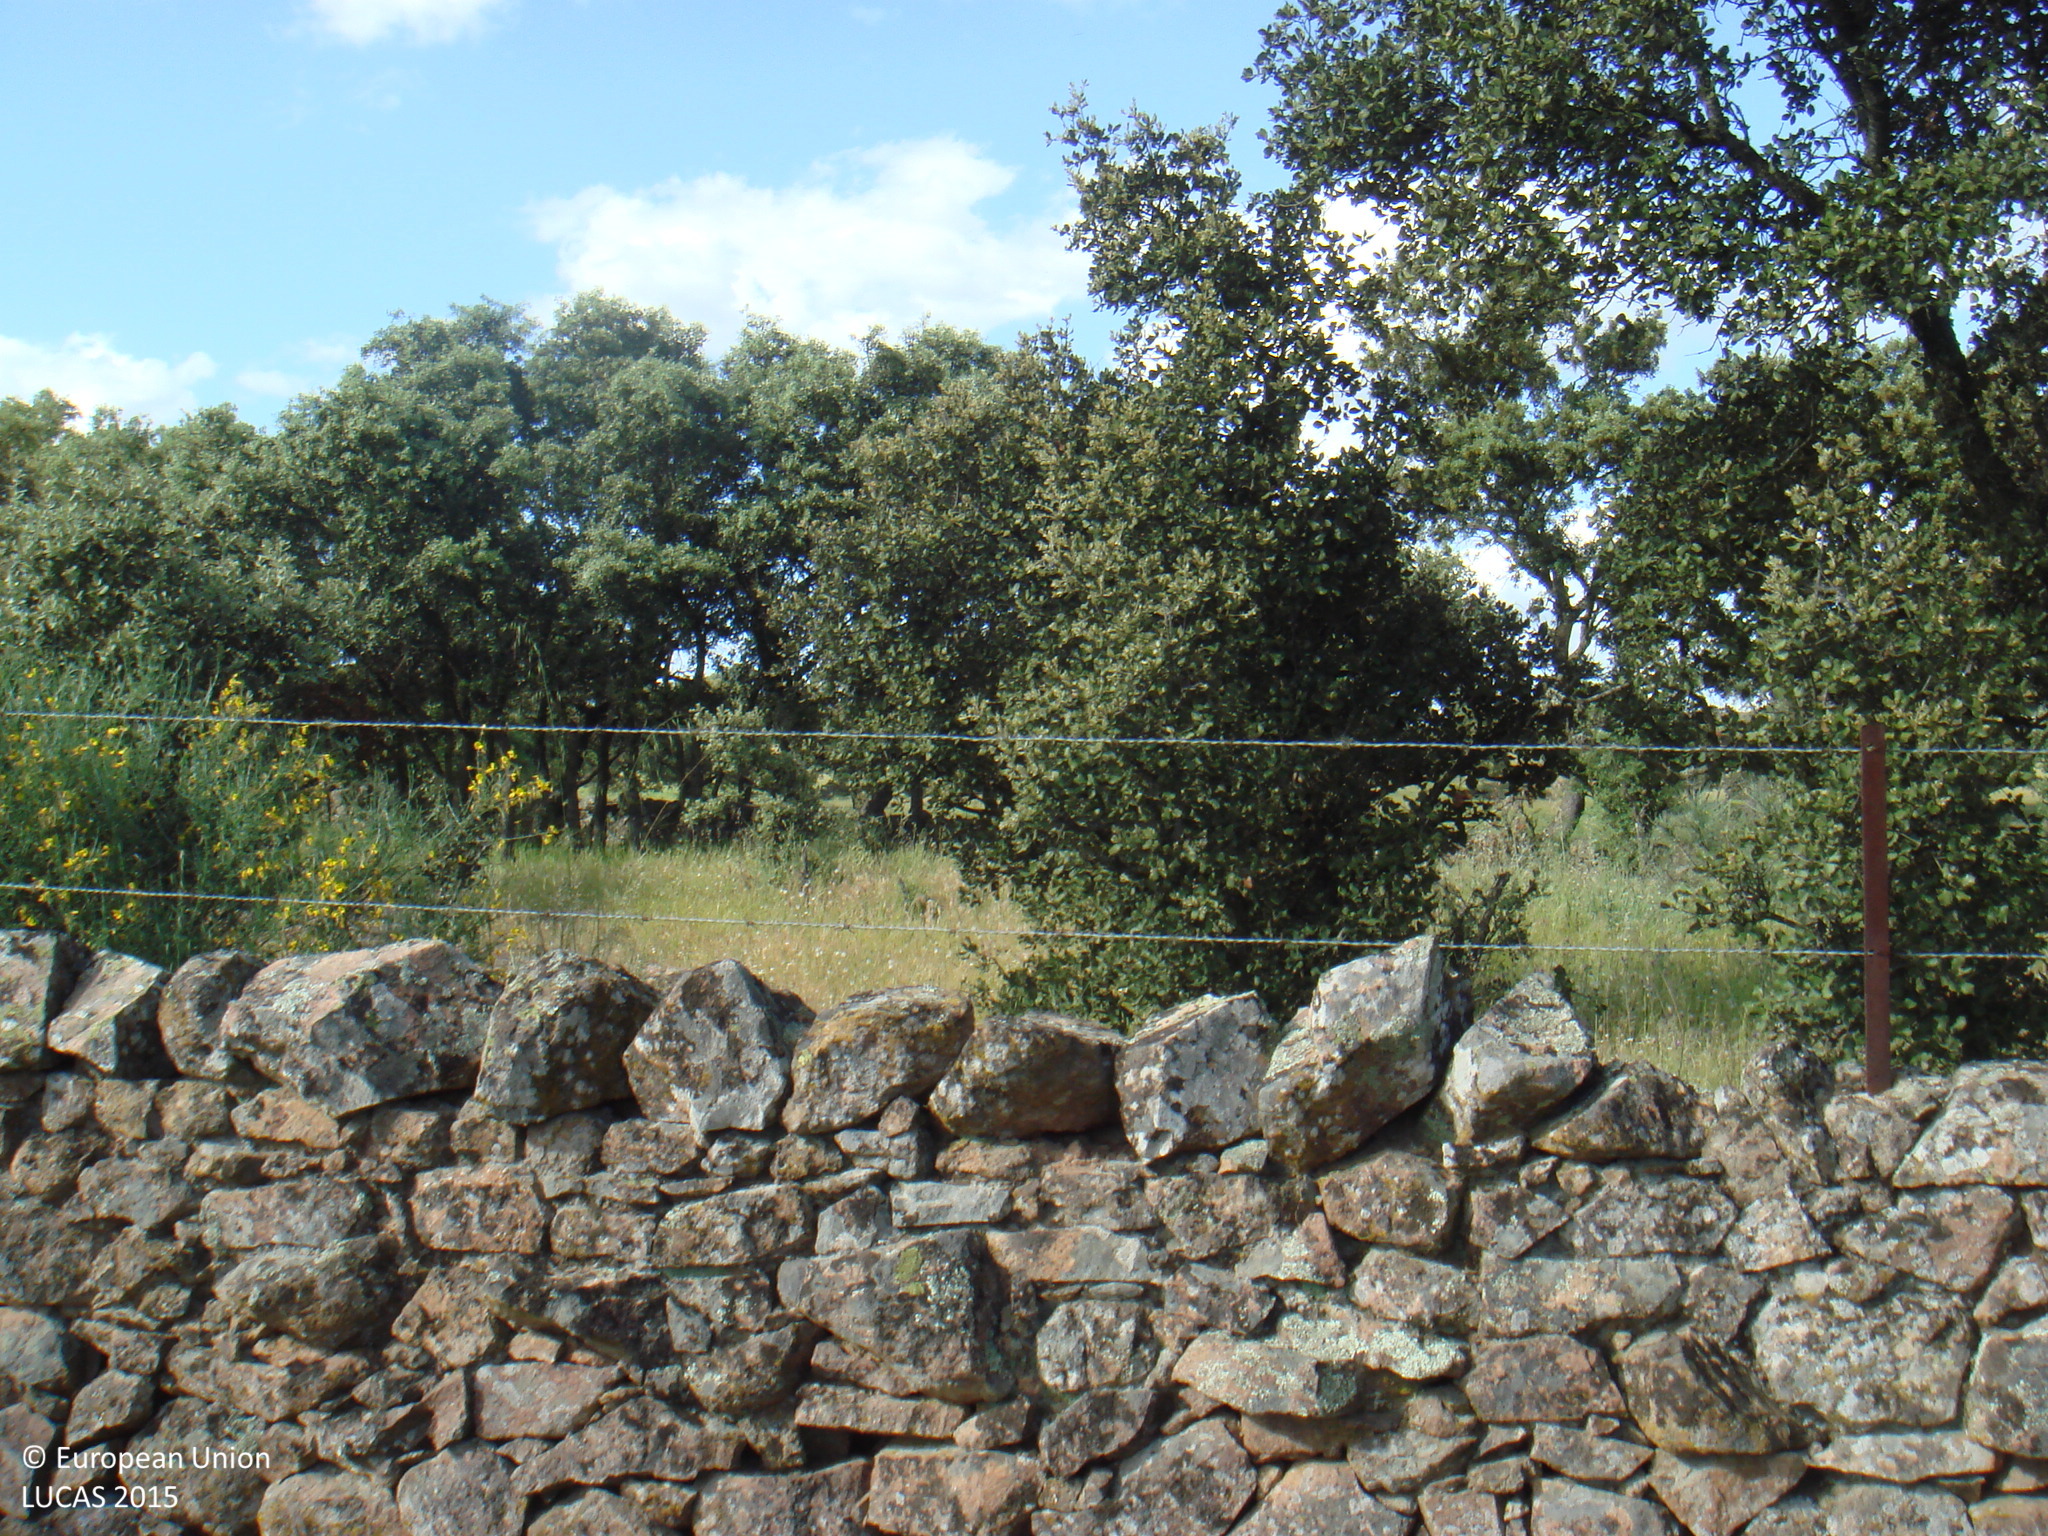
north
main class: Woodland
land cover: Broadleaved woodland
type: broadleaved evergreen forest
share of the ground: 10 - 25 %
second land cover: Shrubland without tree cover
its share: 10 - 25 %
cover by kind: herbaceous plants 70 %, broadleaved forest trees 20 %, shrubs 10 %
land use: Forestry
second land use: Fallow land
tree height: > 5 m
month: May
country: ES
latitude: 38.3771
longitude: -4.7311
